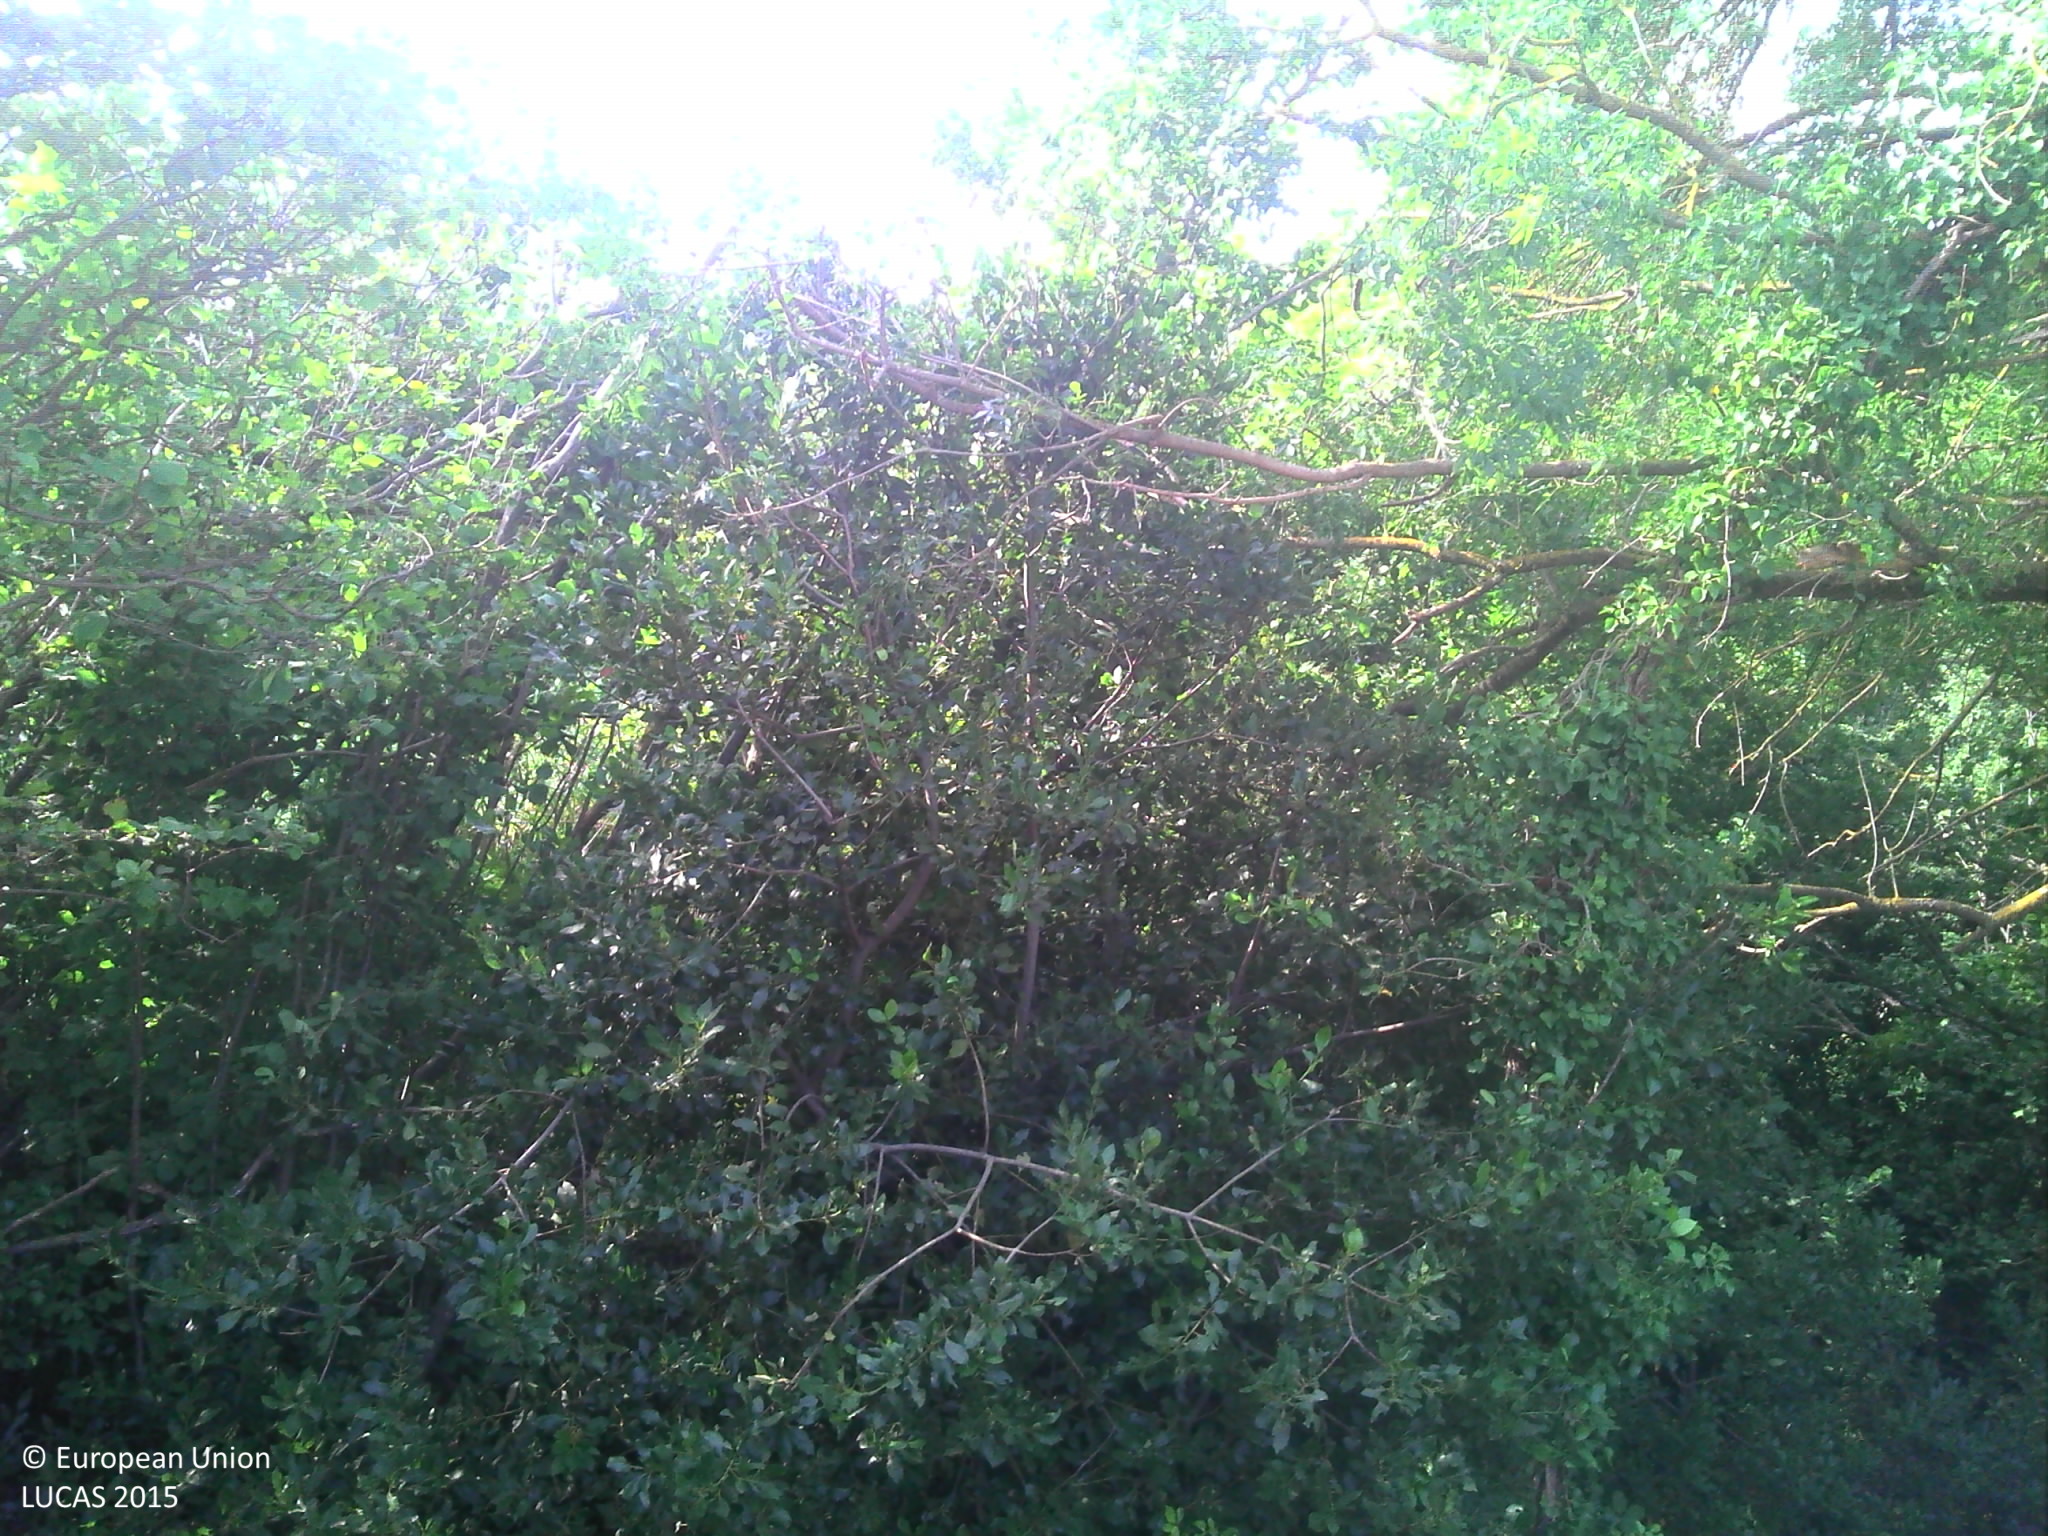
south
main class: Woodland
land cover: Broadleaved woodland
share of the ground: > 75 %
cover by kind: broadleaved forest trees 80 %
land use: Semi-natural and natural areas not in use
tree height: < 5 m
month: July
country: FR
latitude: 43.6176
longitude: 5.0406
